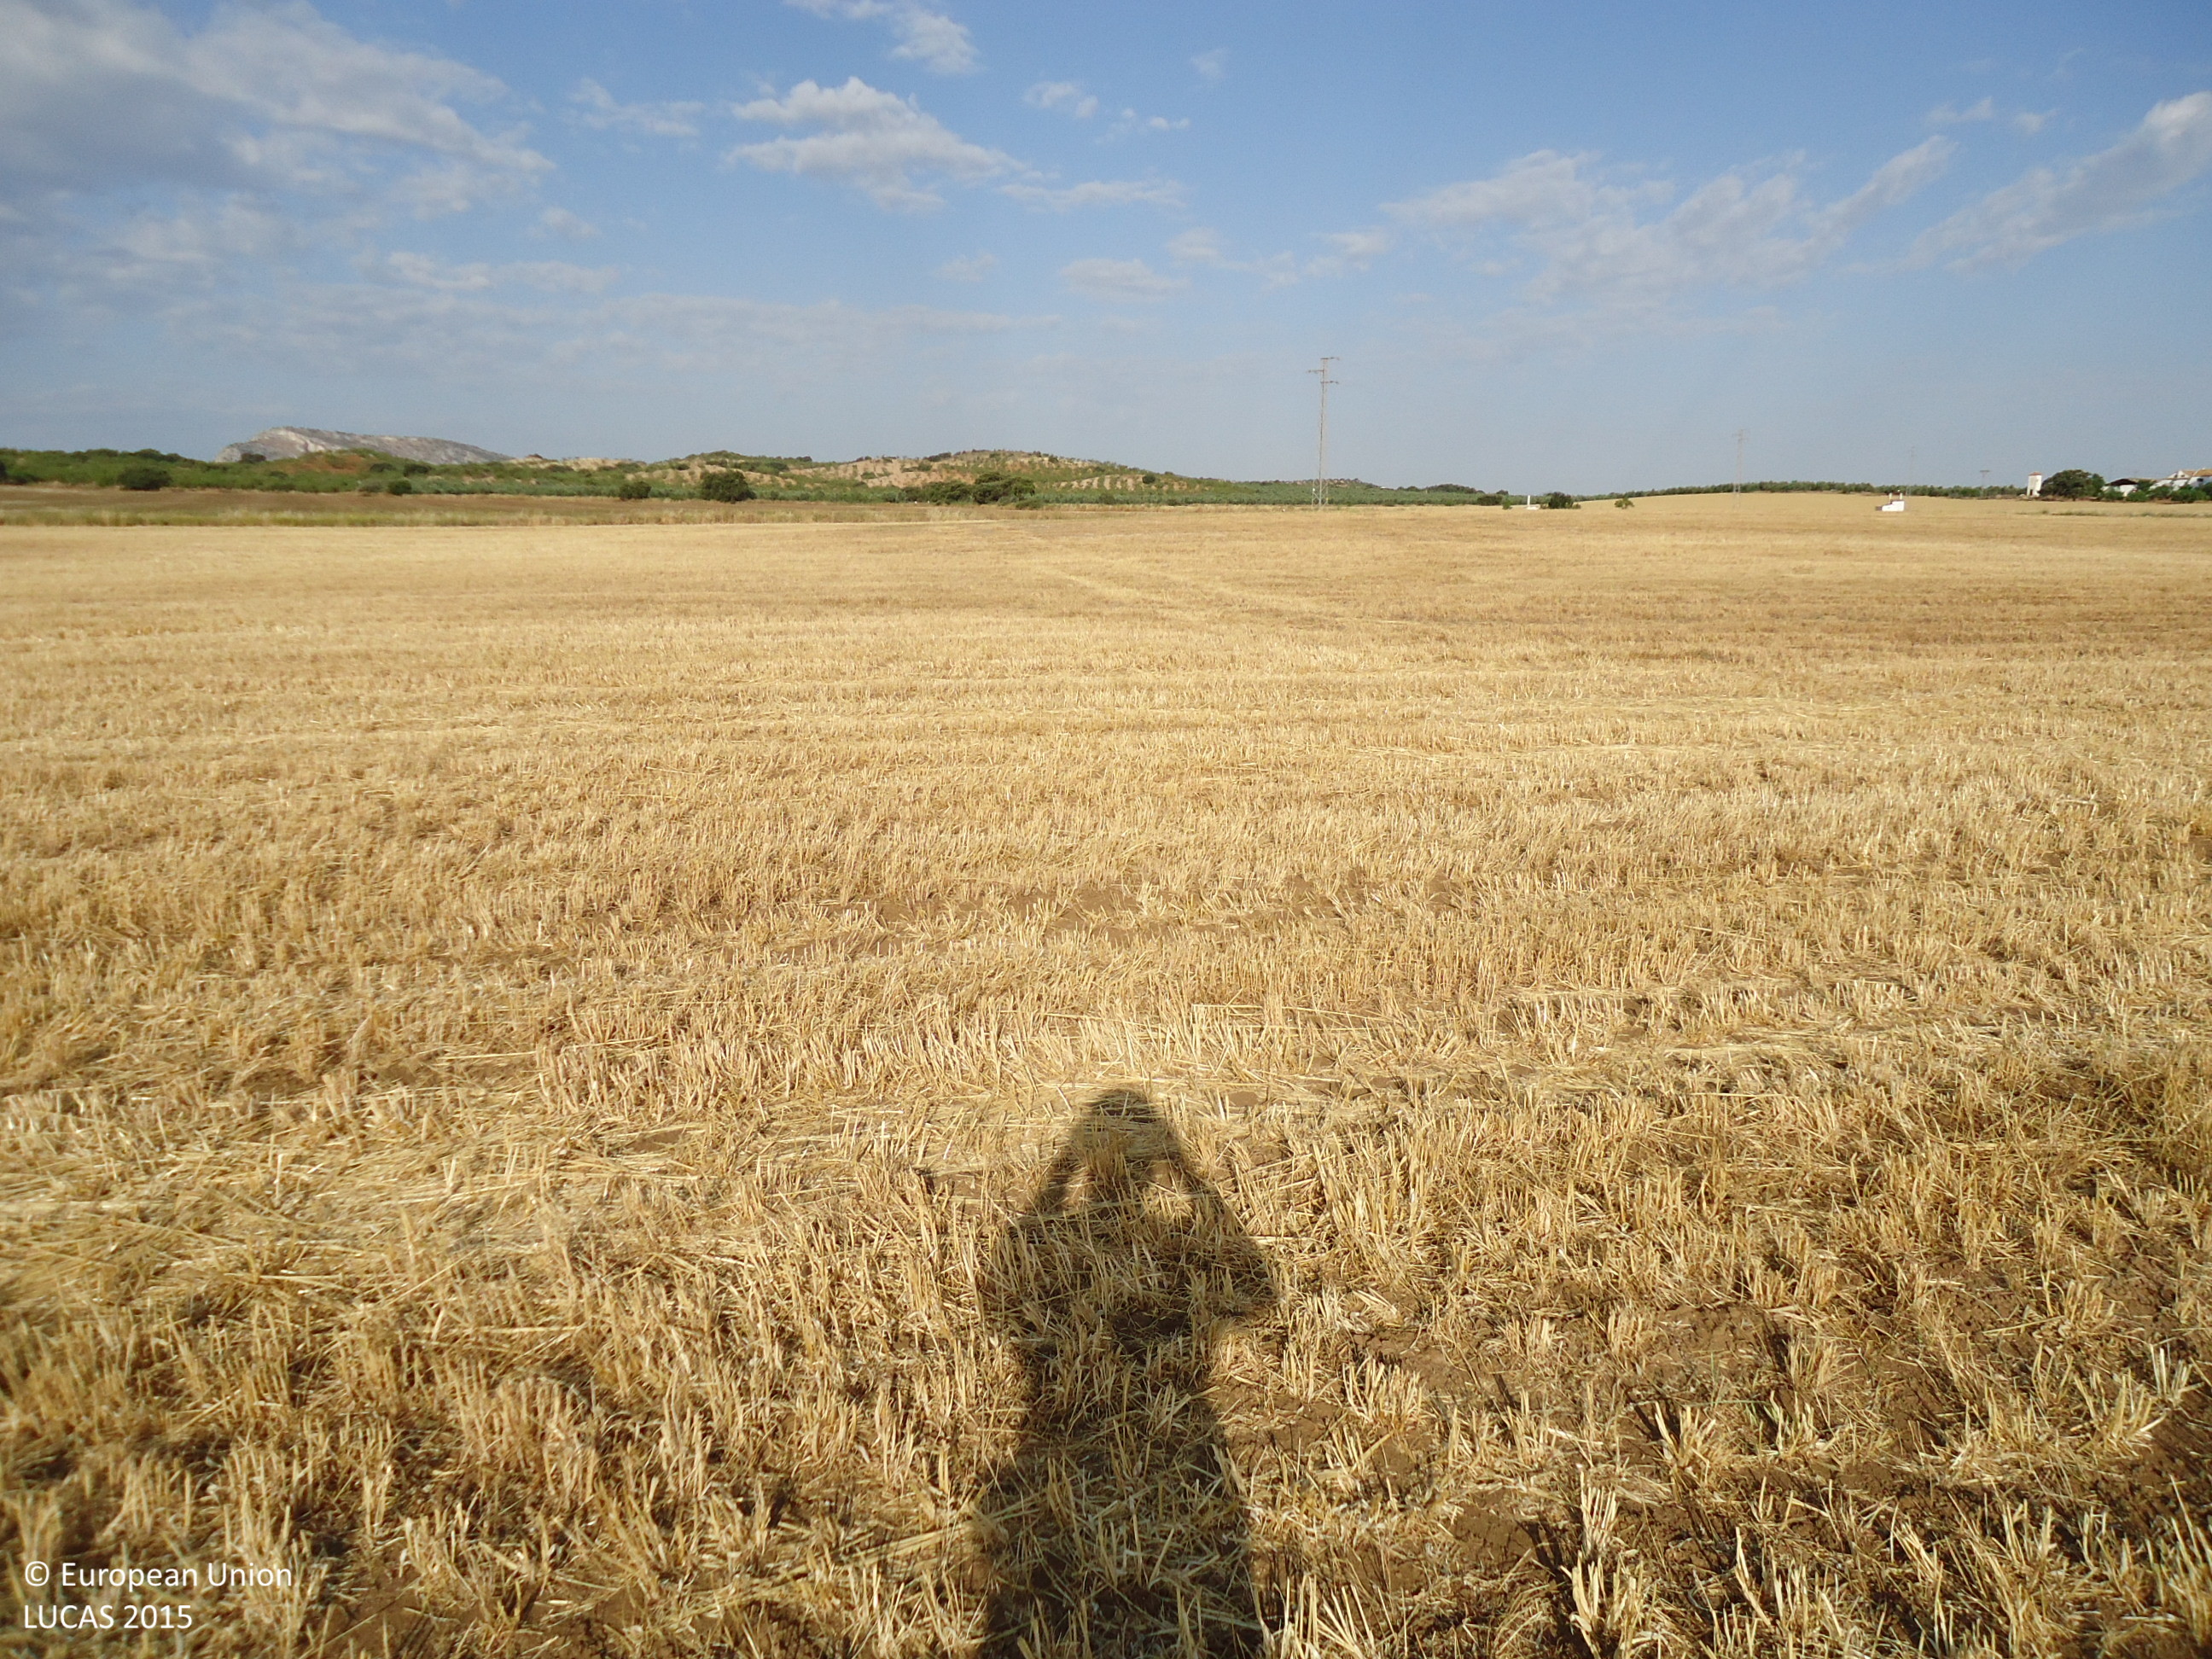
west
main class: Cropland
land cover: Oats
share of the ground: < 10 %
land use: Agriculture (excluding fallow land and kitchen gardens)
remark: Harvested field
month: June
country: ES
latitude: 37.0058
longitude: -4.7997
